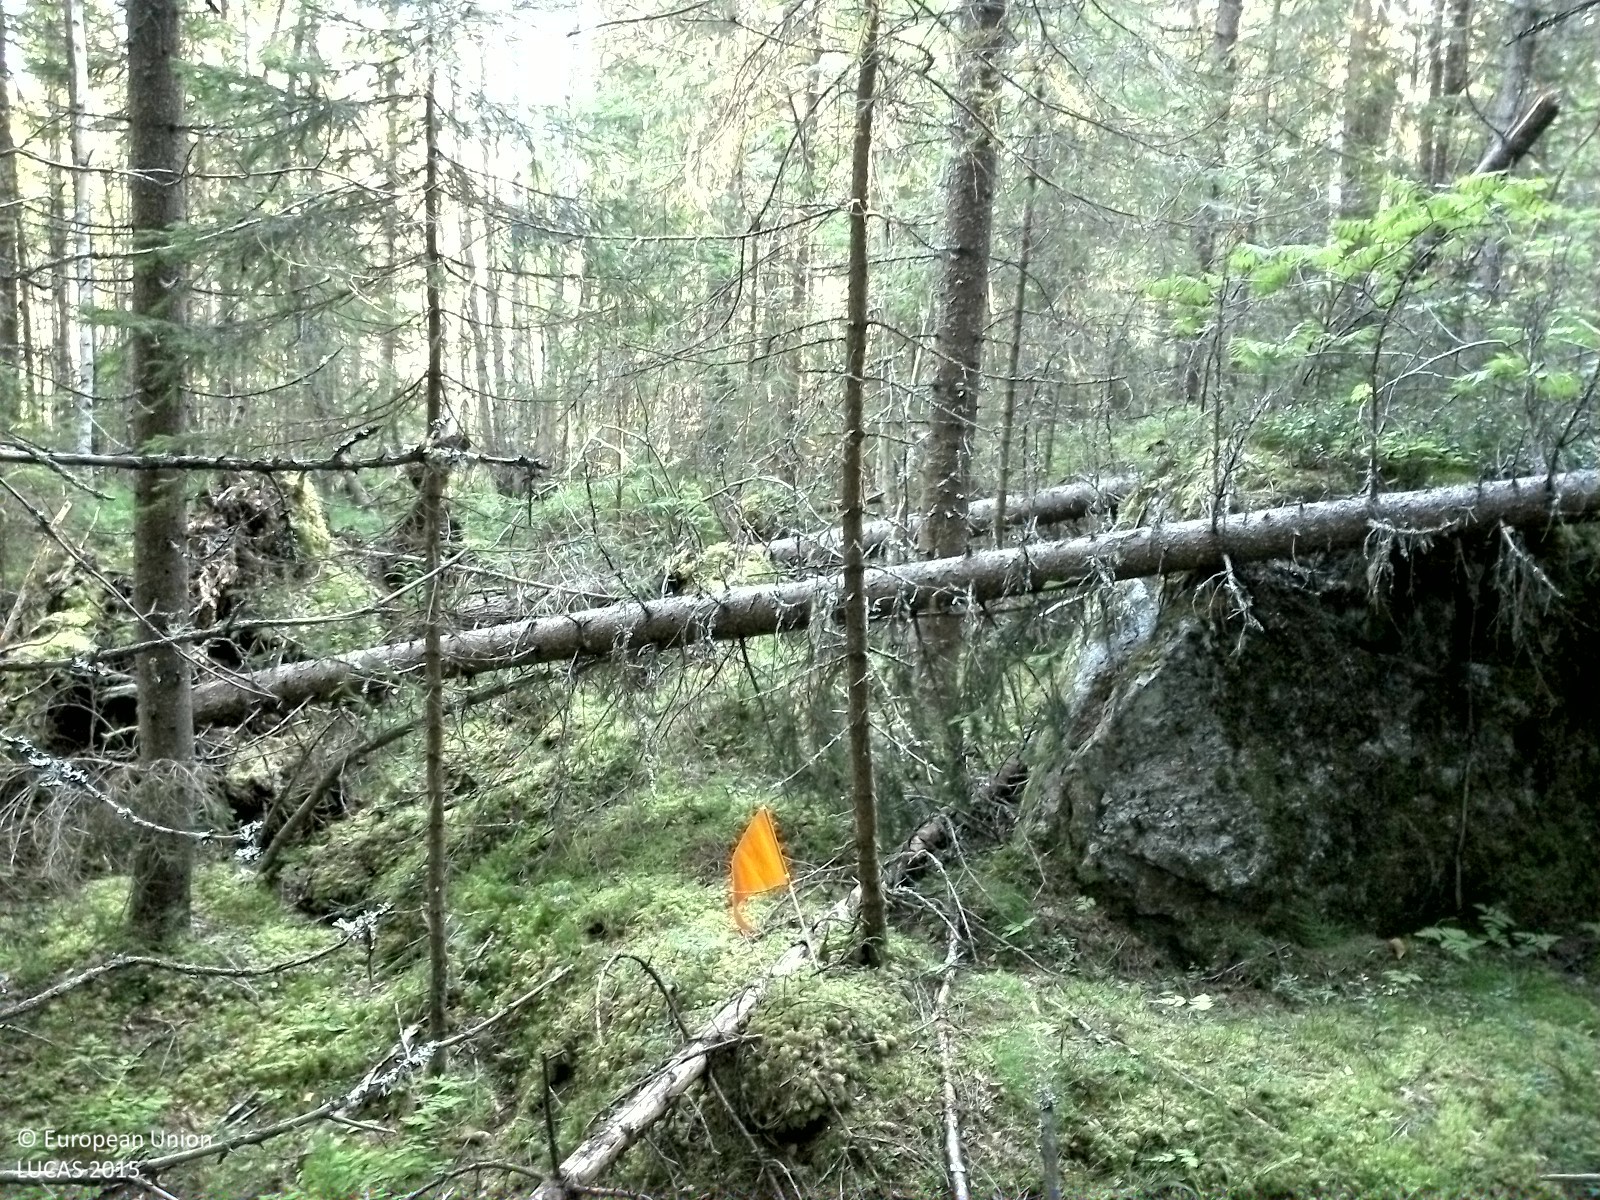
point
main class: Woodland
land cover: Spruce dominated mixed woodland
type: boreal forest
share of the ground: > 75 %
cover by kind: coniferous forest trees 60 %, broadleaved forest trees 20 %, lichens and mosses 20 %
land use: Forestry
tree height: > 5 m
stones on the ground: < 10 %
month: August
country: SE
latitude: 62.3143
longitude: 16.7906
